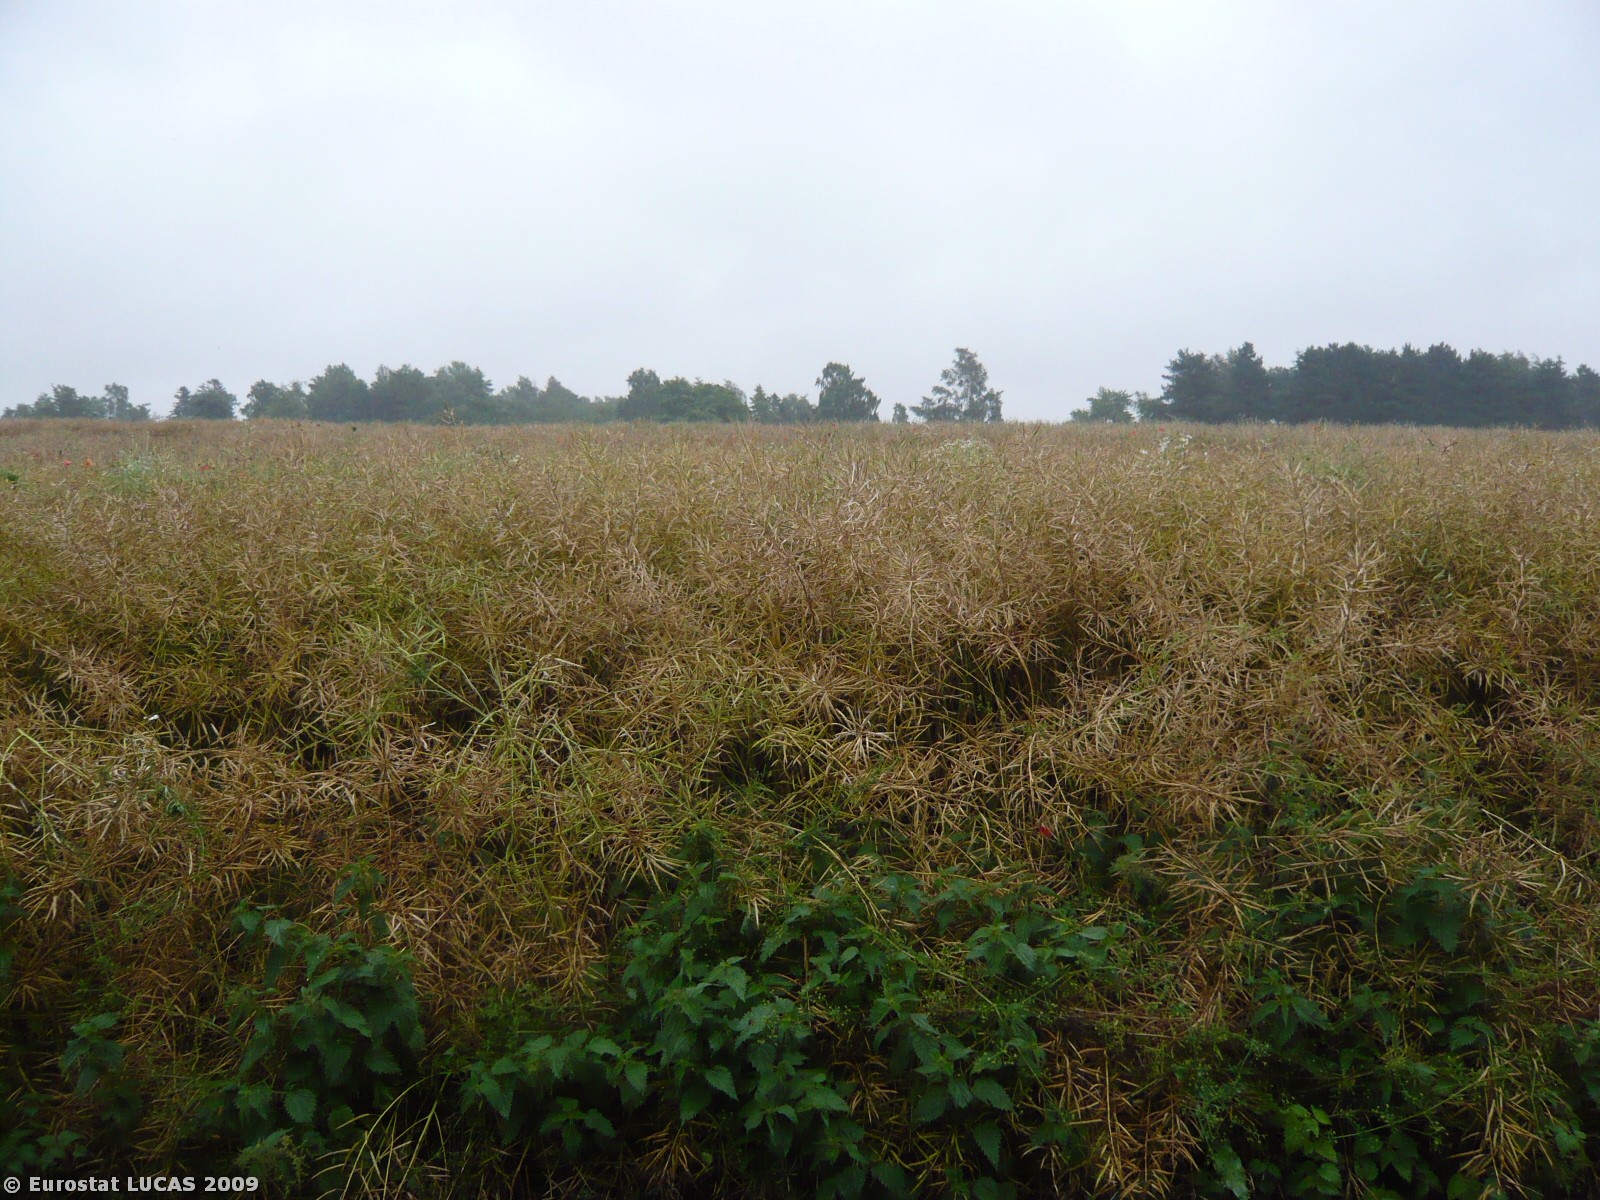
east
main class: Cropland
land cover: Rape and turnip rape
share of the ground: > 75 %
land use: Agriculture (excluding fallow land and kitchen gardens)
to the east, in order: Rape and turnip rape; Managed hedges; Artificial constructions in urban areas
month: July
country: DK
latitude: 55.7787
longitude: 11.8637
